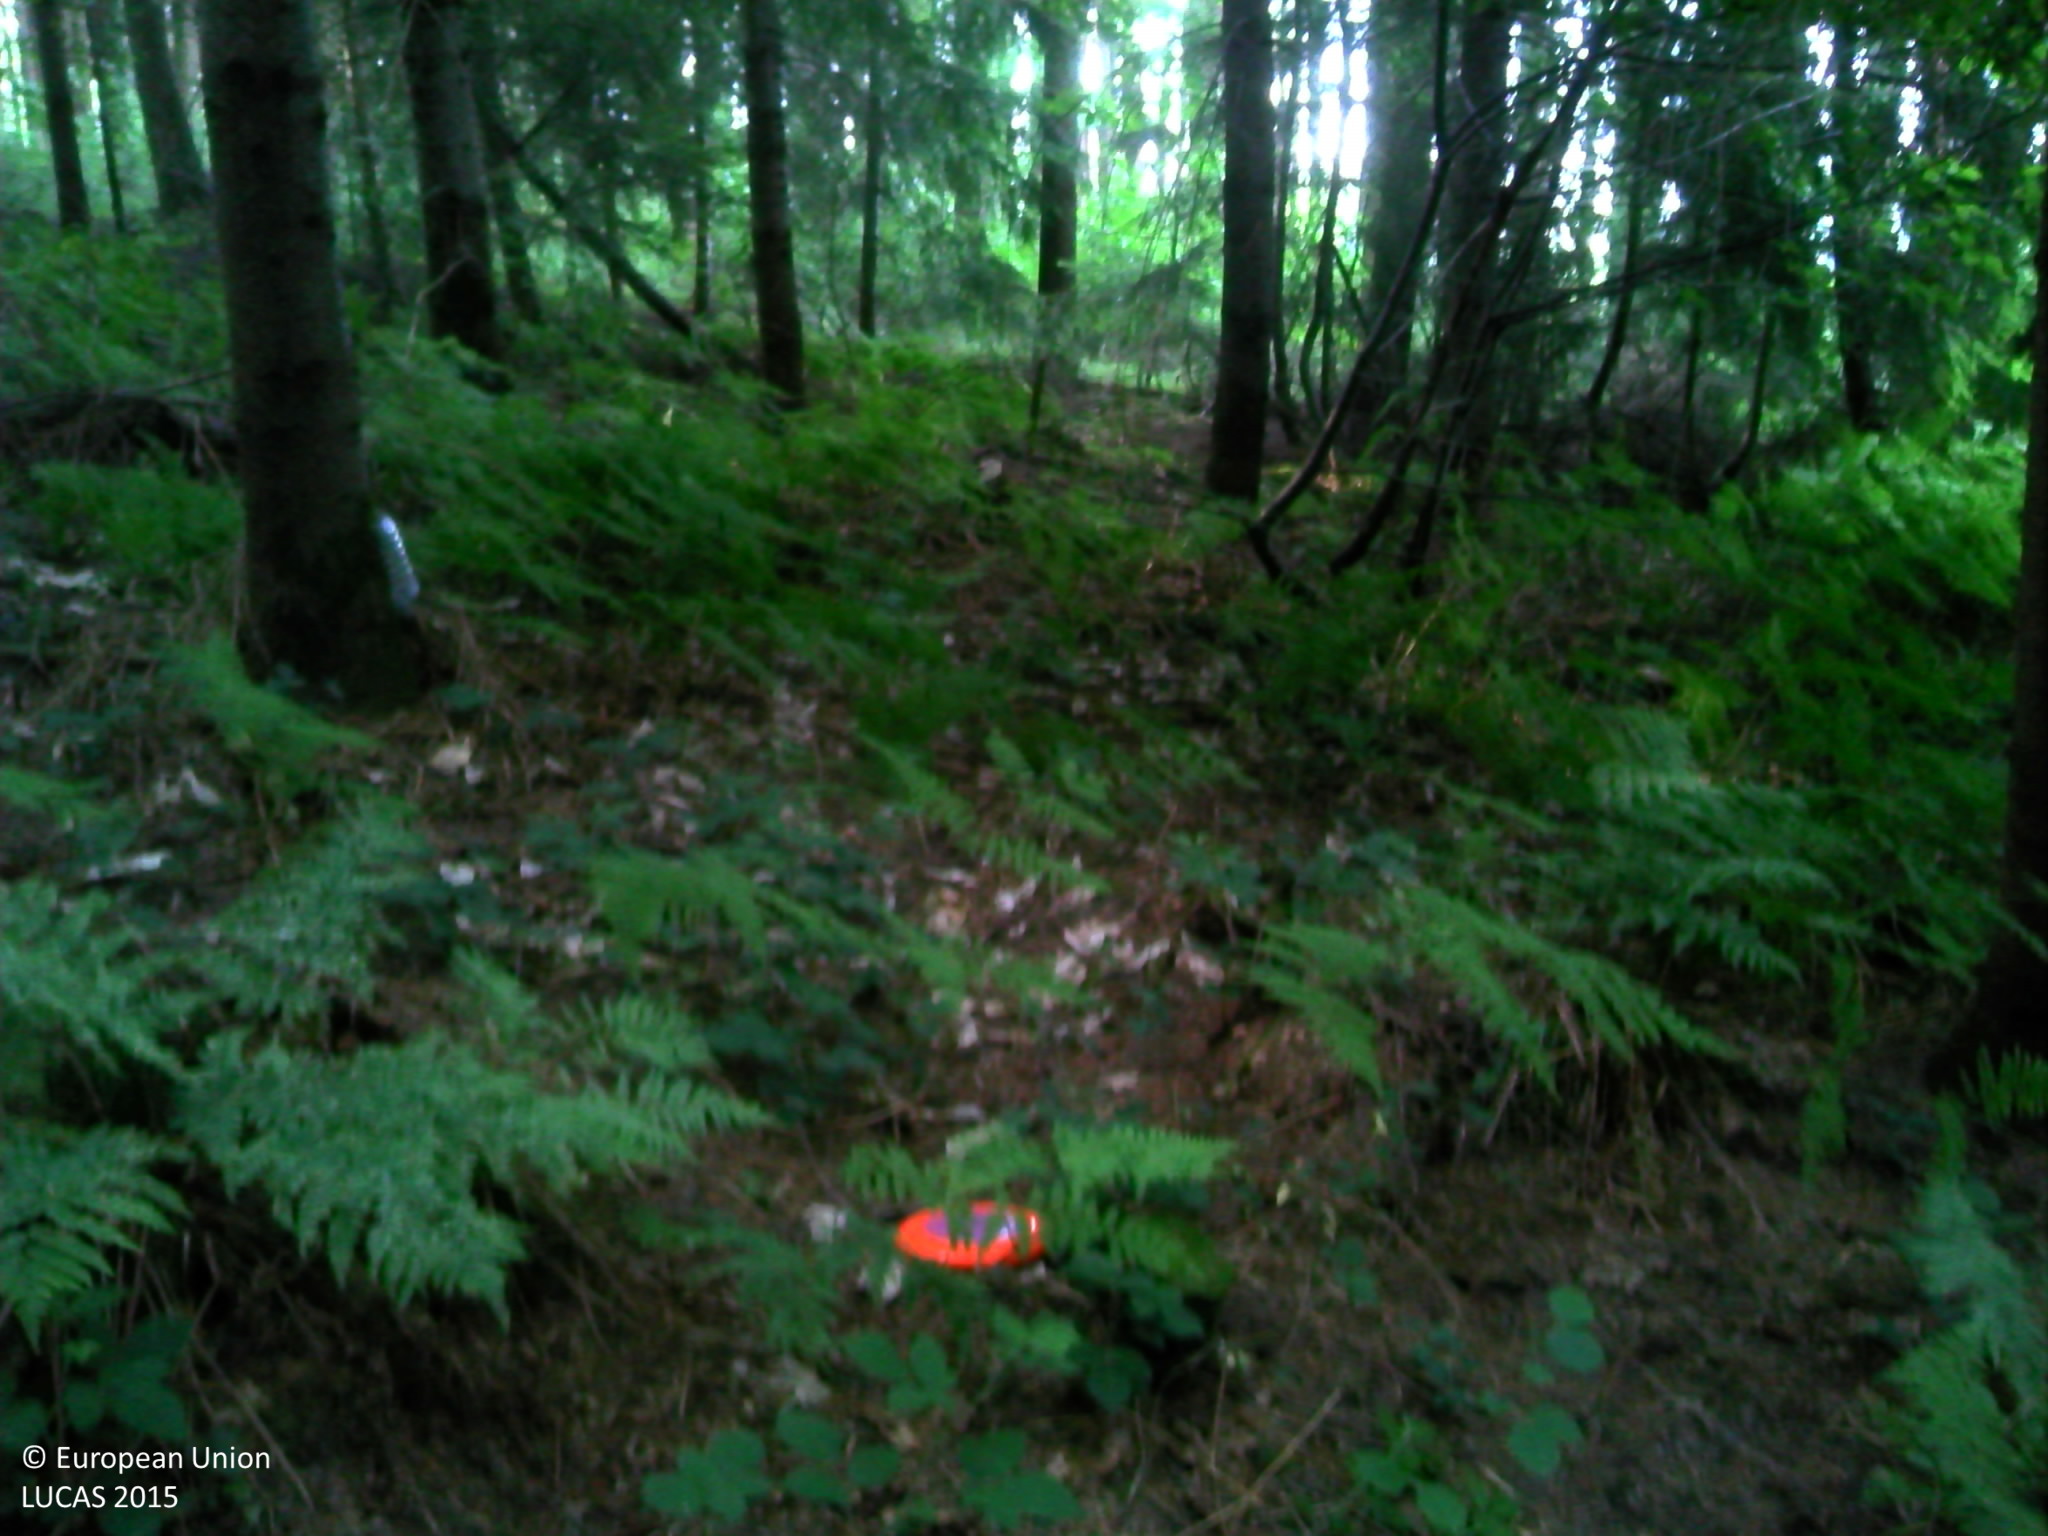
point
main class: Woodland
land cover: Spruce dominated coniferous woodland
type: exotic forest
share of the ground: > 75 %
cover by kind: coniferous forest trees 80 %, herbaceous plants 20 %
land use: Forestry
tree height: > 5 m
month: June
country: FR
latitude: 46.3862
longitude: 4.4231
